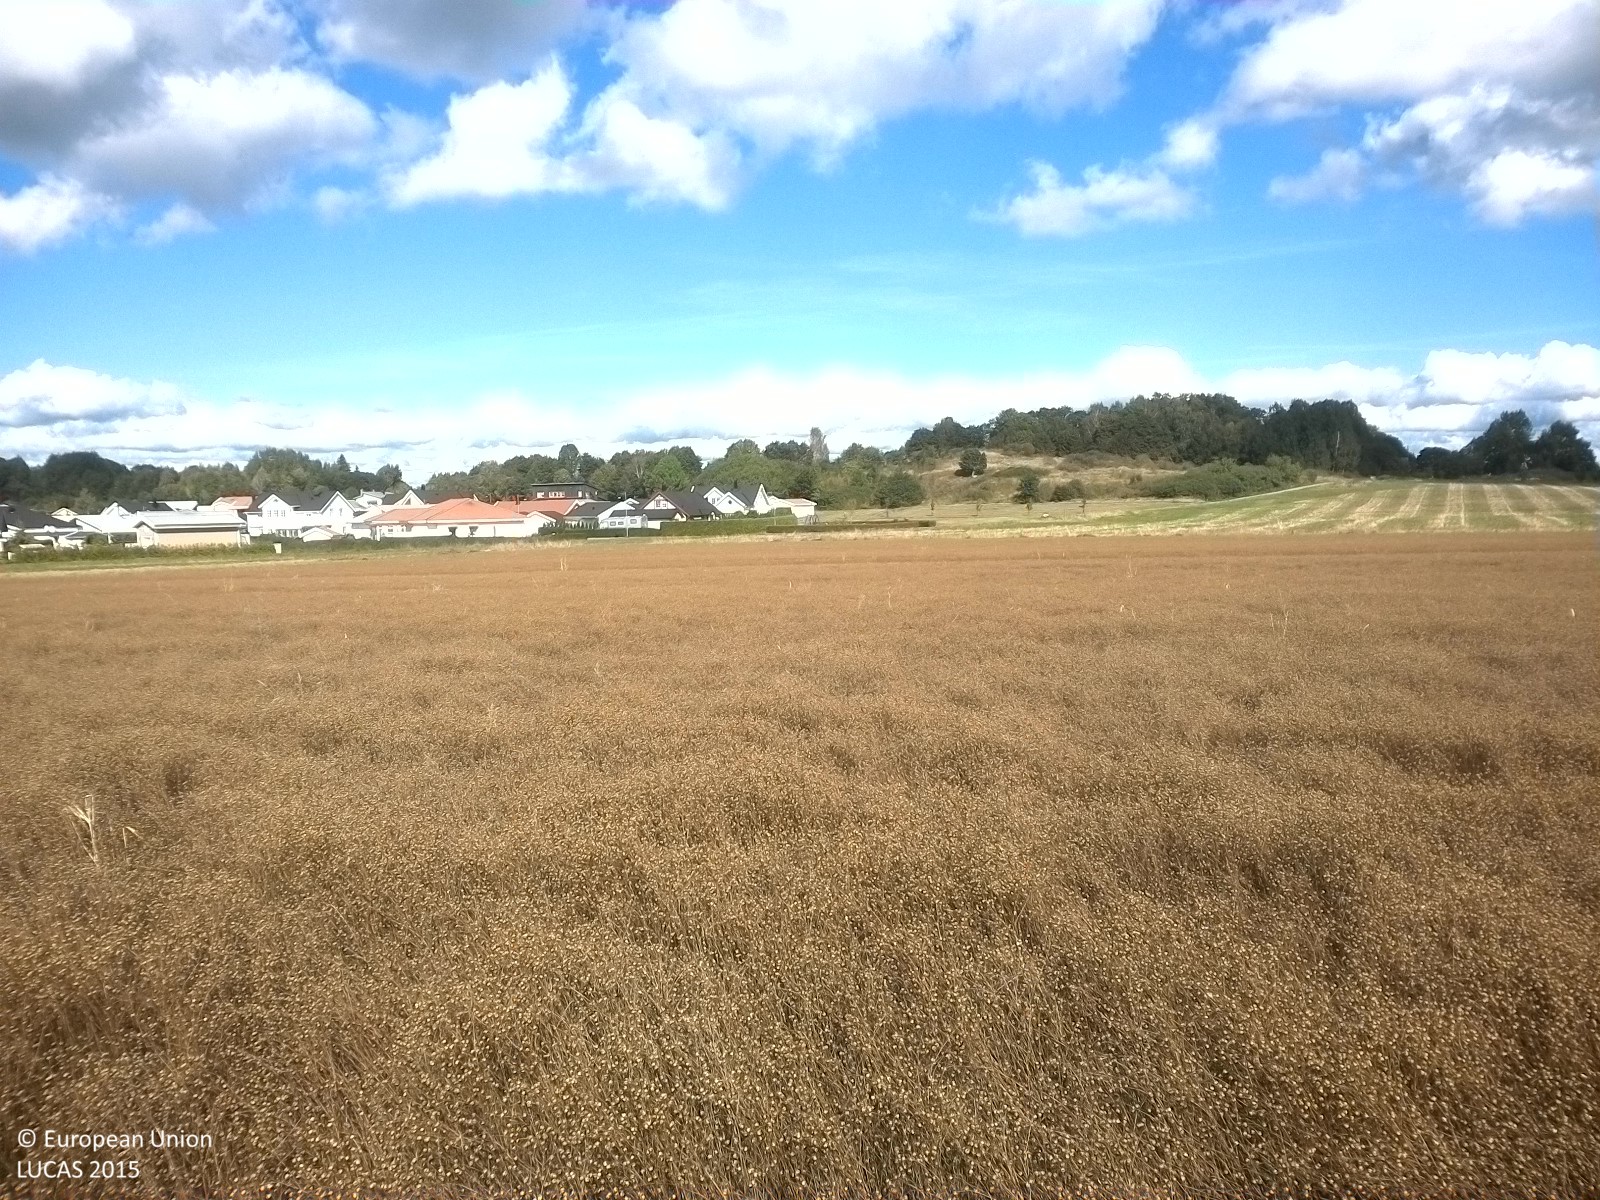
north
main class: Cropland
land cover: Other fibre and oleaginous crops
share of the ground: > 75 %
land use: Agriculture (excluding fallow land and kitchen gardens)
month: September
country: SE
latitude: 58.5622
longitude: 16.2351
